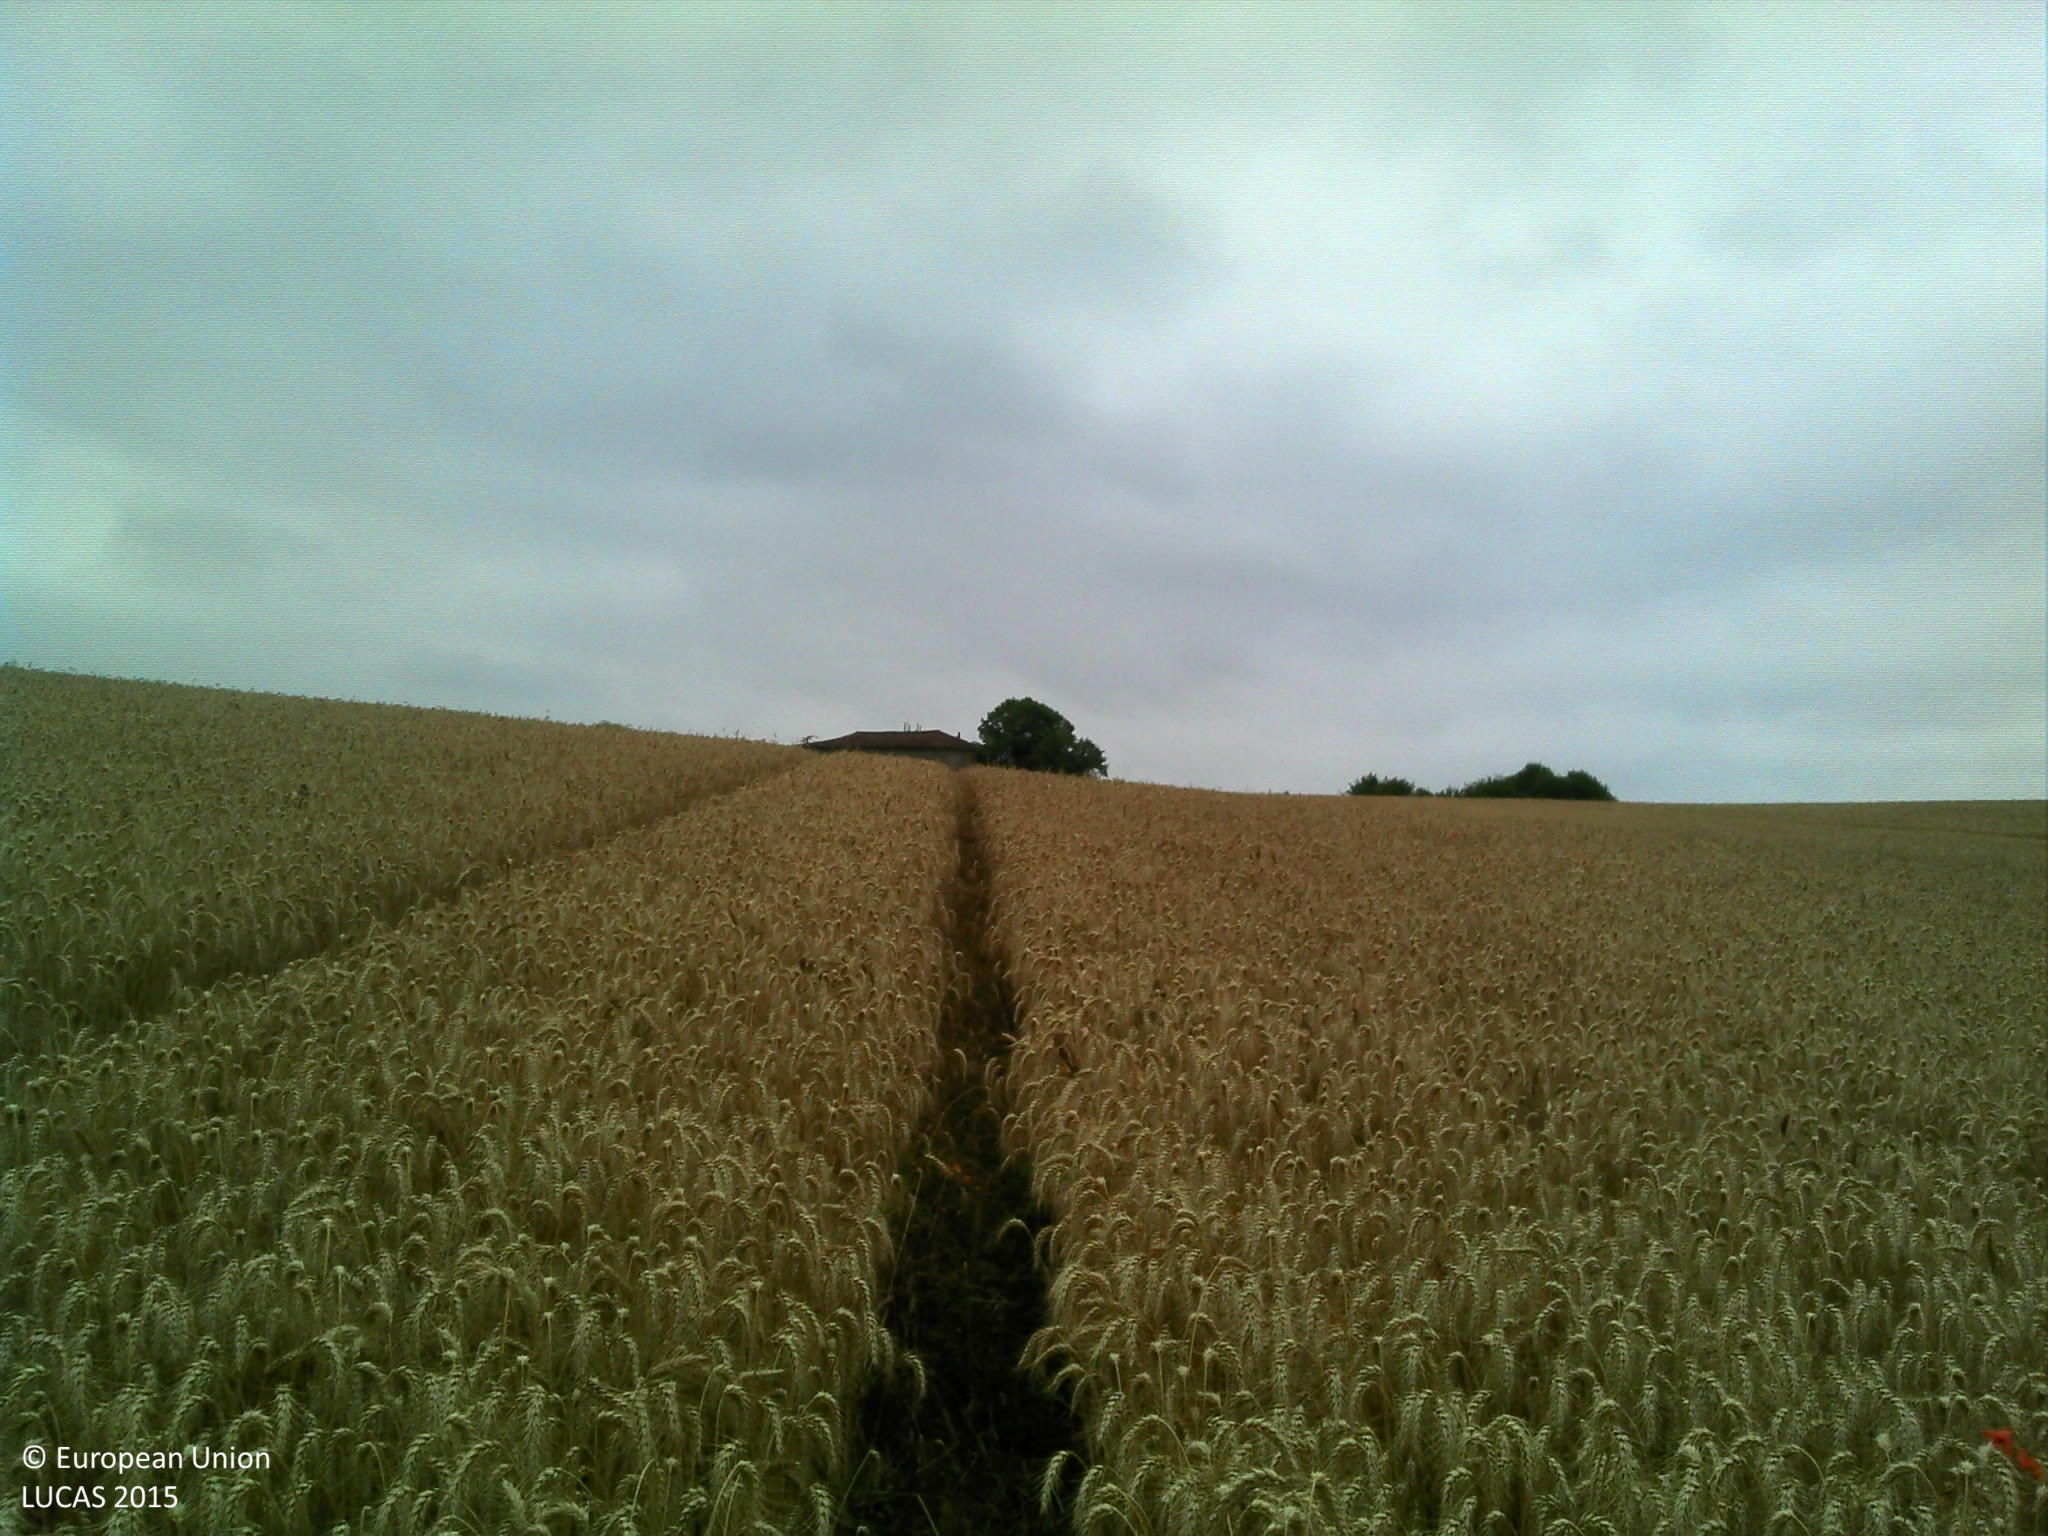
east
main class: Cropland
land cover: Durum wheat
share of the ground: > 75 %
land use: Agriculture (excluding fallow land and kitchen gardens)
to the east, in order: Durum wheat; Artificial constructions in urban areas; Durum wheat; Grass margins; Electric lines; Lucerne
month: June
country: FR
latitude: 44.0586
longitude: 0.8970
